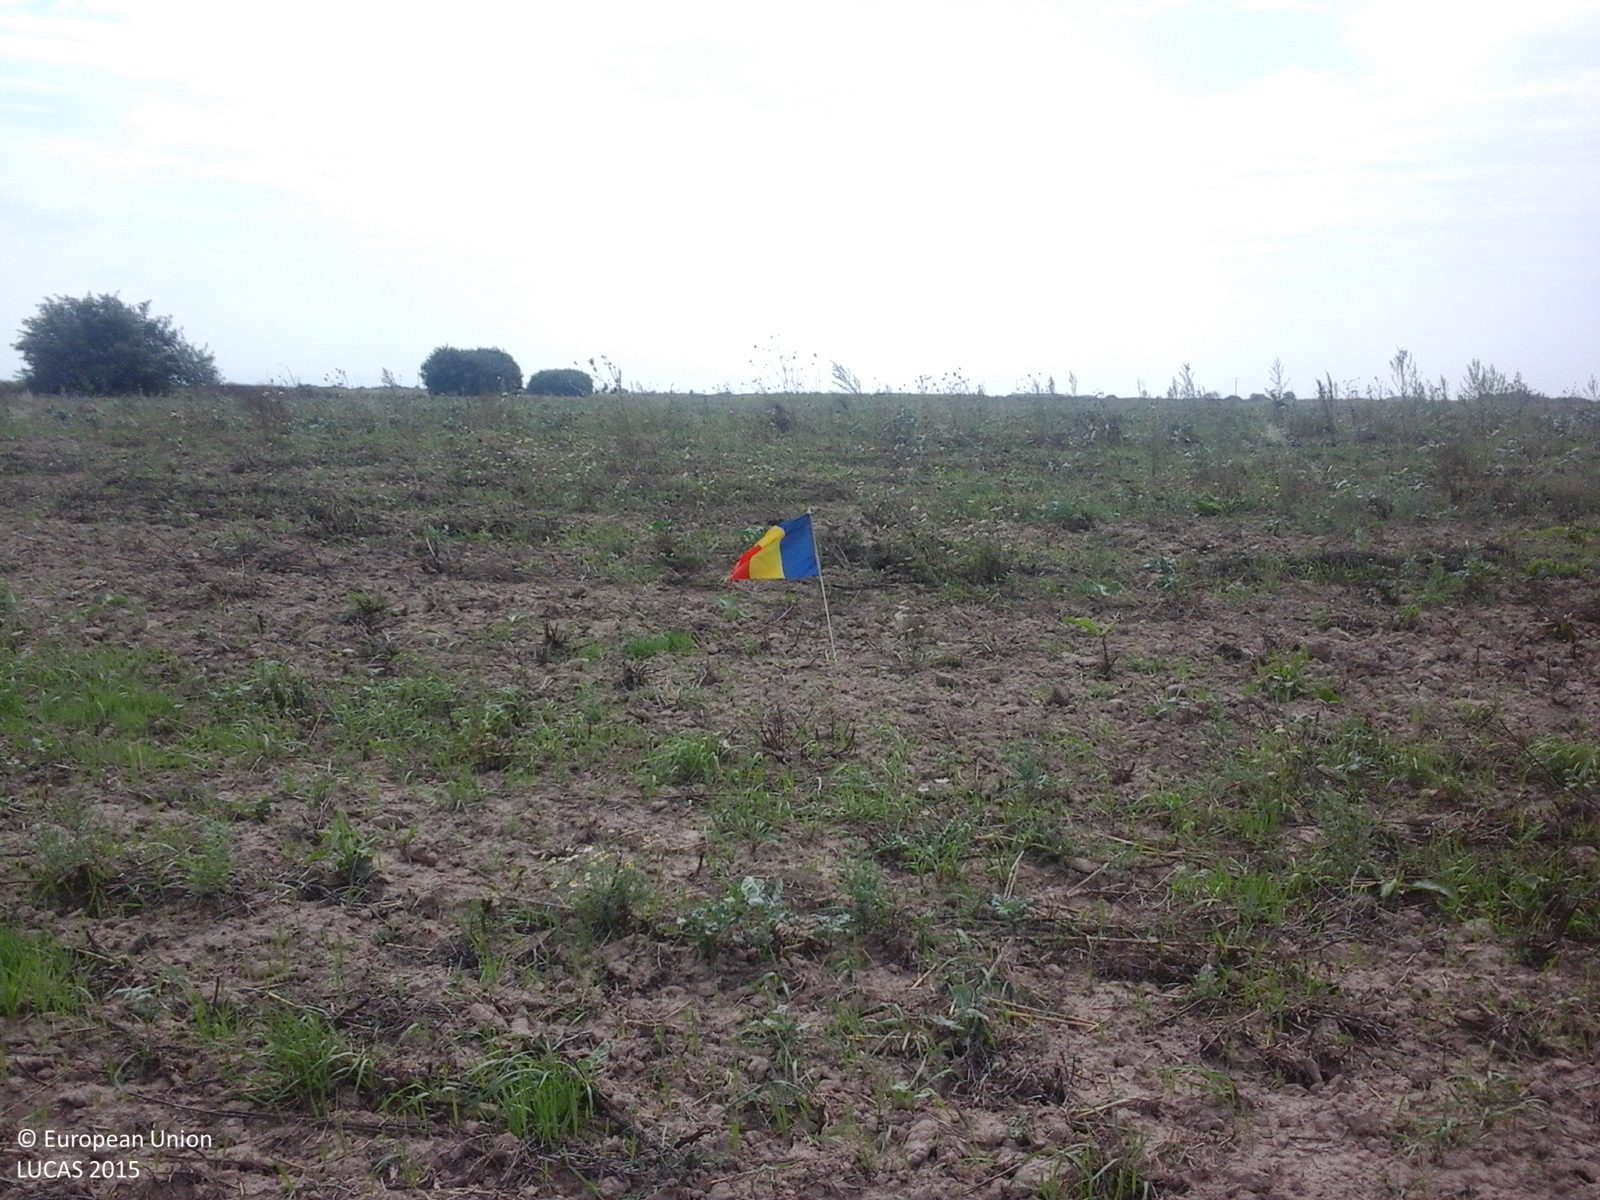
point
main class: Grassland
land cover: Spontaneously vegetated surfaces
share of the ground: 25 - 50 %
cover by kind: herbaceous plants 100 %
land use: Fallow land
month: August
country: RO
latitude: 46.5720
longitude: 21.7713
